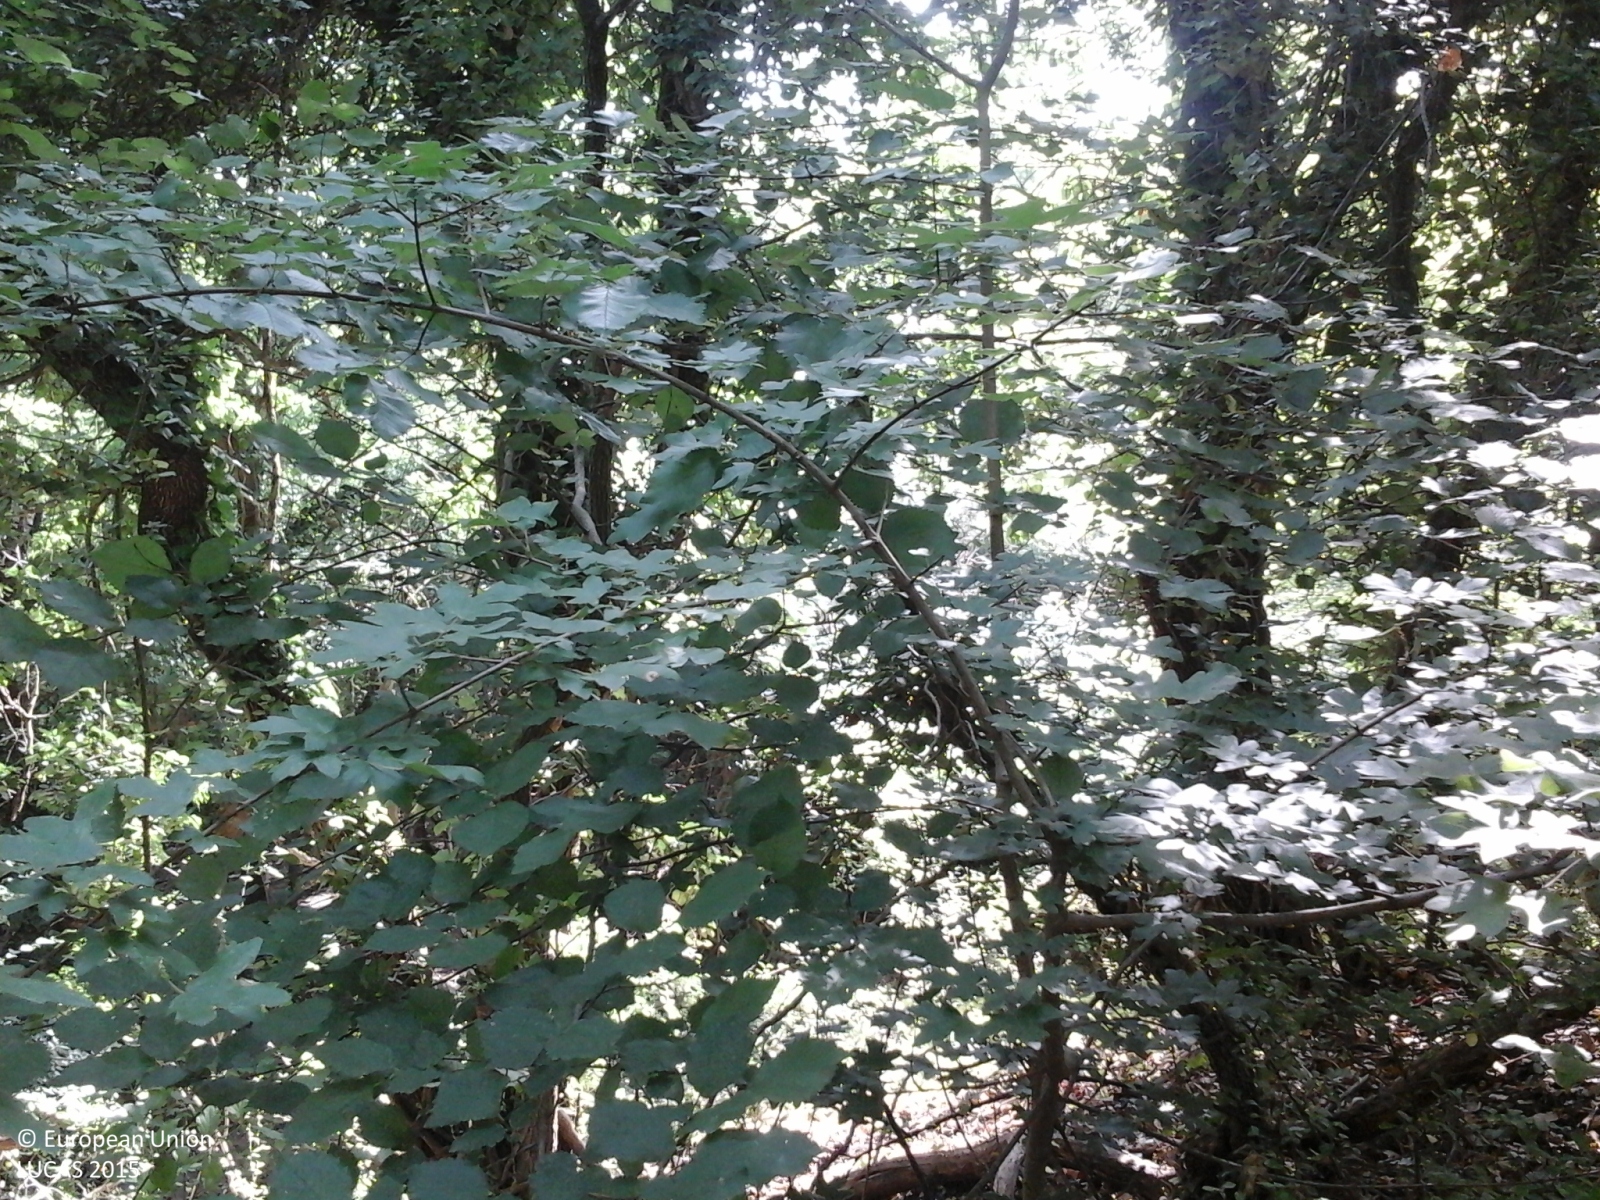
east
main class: Woodland
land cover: Broadleaved woodland
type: thermophilous deciduous forest
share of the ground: > 75 %
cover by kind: broadleaved forest trees 90 %, shrubs 10 %
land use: Forestry
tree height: > 5 m
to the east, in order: Broadleaved woodland
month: June
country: IT
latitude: 44.2655
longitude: 11.6373
